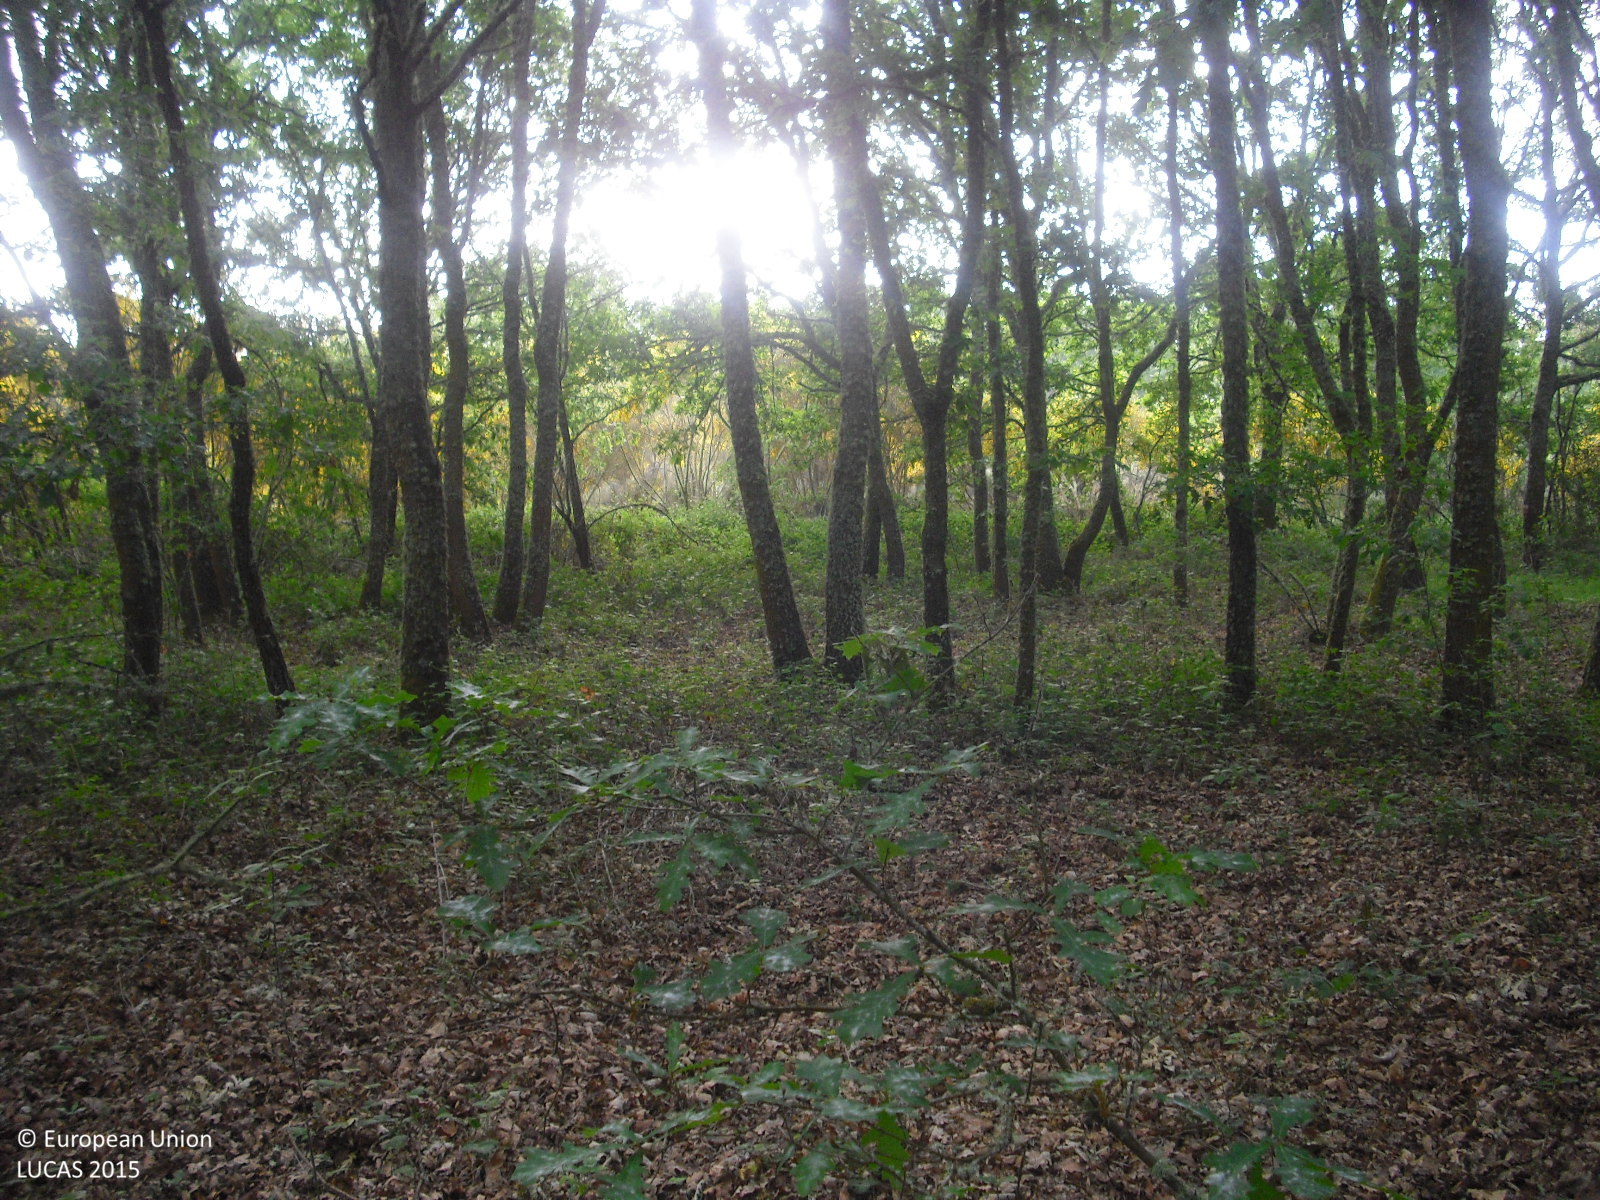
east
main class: Woodland
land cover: Broadleaved woodland
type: acidophilous oak and oak-birch forest
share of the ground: > 75 %
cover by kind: broadleaved forest trees 80 %, shrubs 20 %
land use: Forestry
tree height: > 5 m
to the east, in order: Broadleaved woodland; Shrubland with sparse tree cover; Shrubland without tree cover; Single bushes/trees; Shrubland without tree cover; Broadleaved woodland; Pine dominated coniferous woodland; Dry stone walls; Broadleaved woodland; Dry stone walls; Broadleaved woodland; Shrubland with sparse tree cover; Broadleaved woodland; Dry stone walls; Tracks; Dry stone walls; Shrubland with sparse tree cover; Broadleaved woodland; Dry stone walls; Tracks; Dry stone walls; Broadleaved woodland
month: May
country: ES
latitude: 42.2073
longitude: -7.7934
